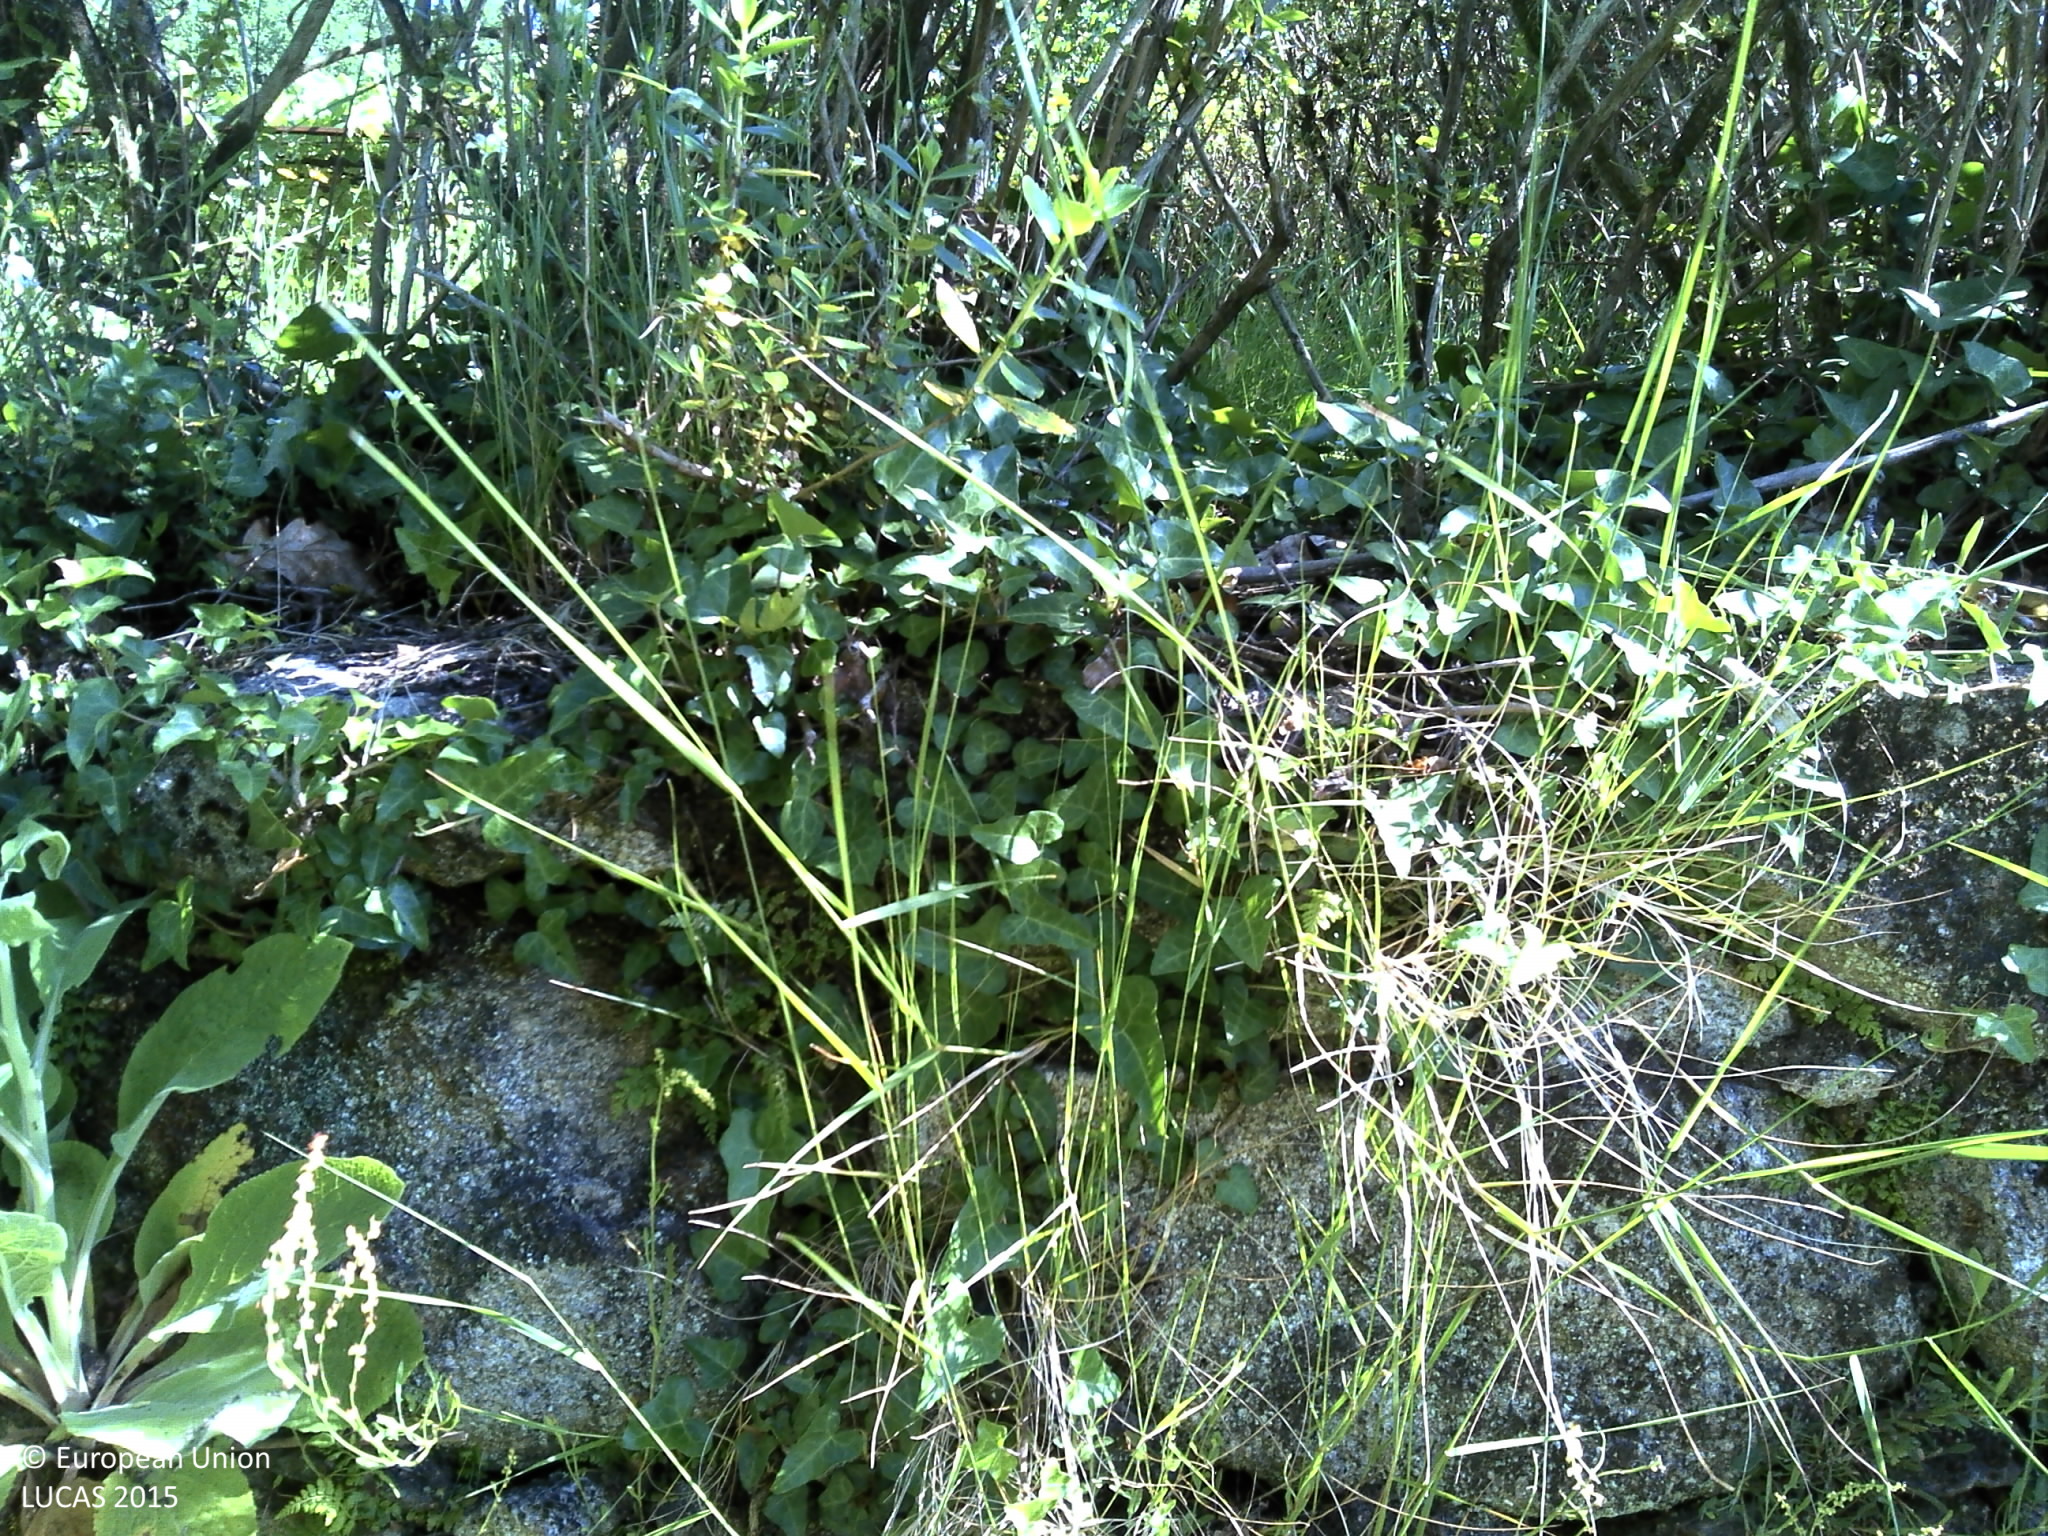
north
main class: Shrubland
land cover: Shrubland with sparse tree cover
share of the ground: 50 - 75 %
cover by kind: shrubs 60 %, unconsolidated bare surface 20 %, herbaceous plants 15 %, broadleaved forest trees 5 %
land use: Semi-natural and natural areas not in use
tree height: > 5 m
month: May
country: PT
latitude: 41.9112
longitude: -8.6982
